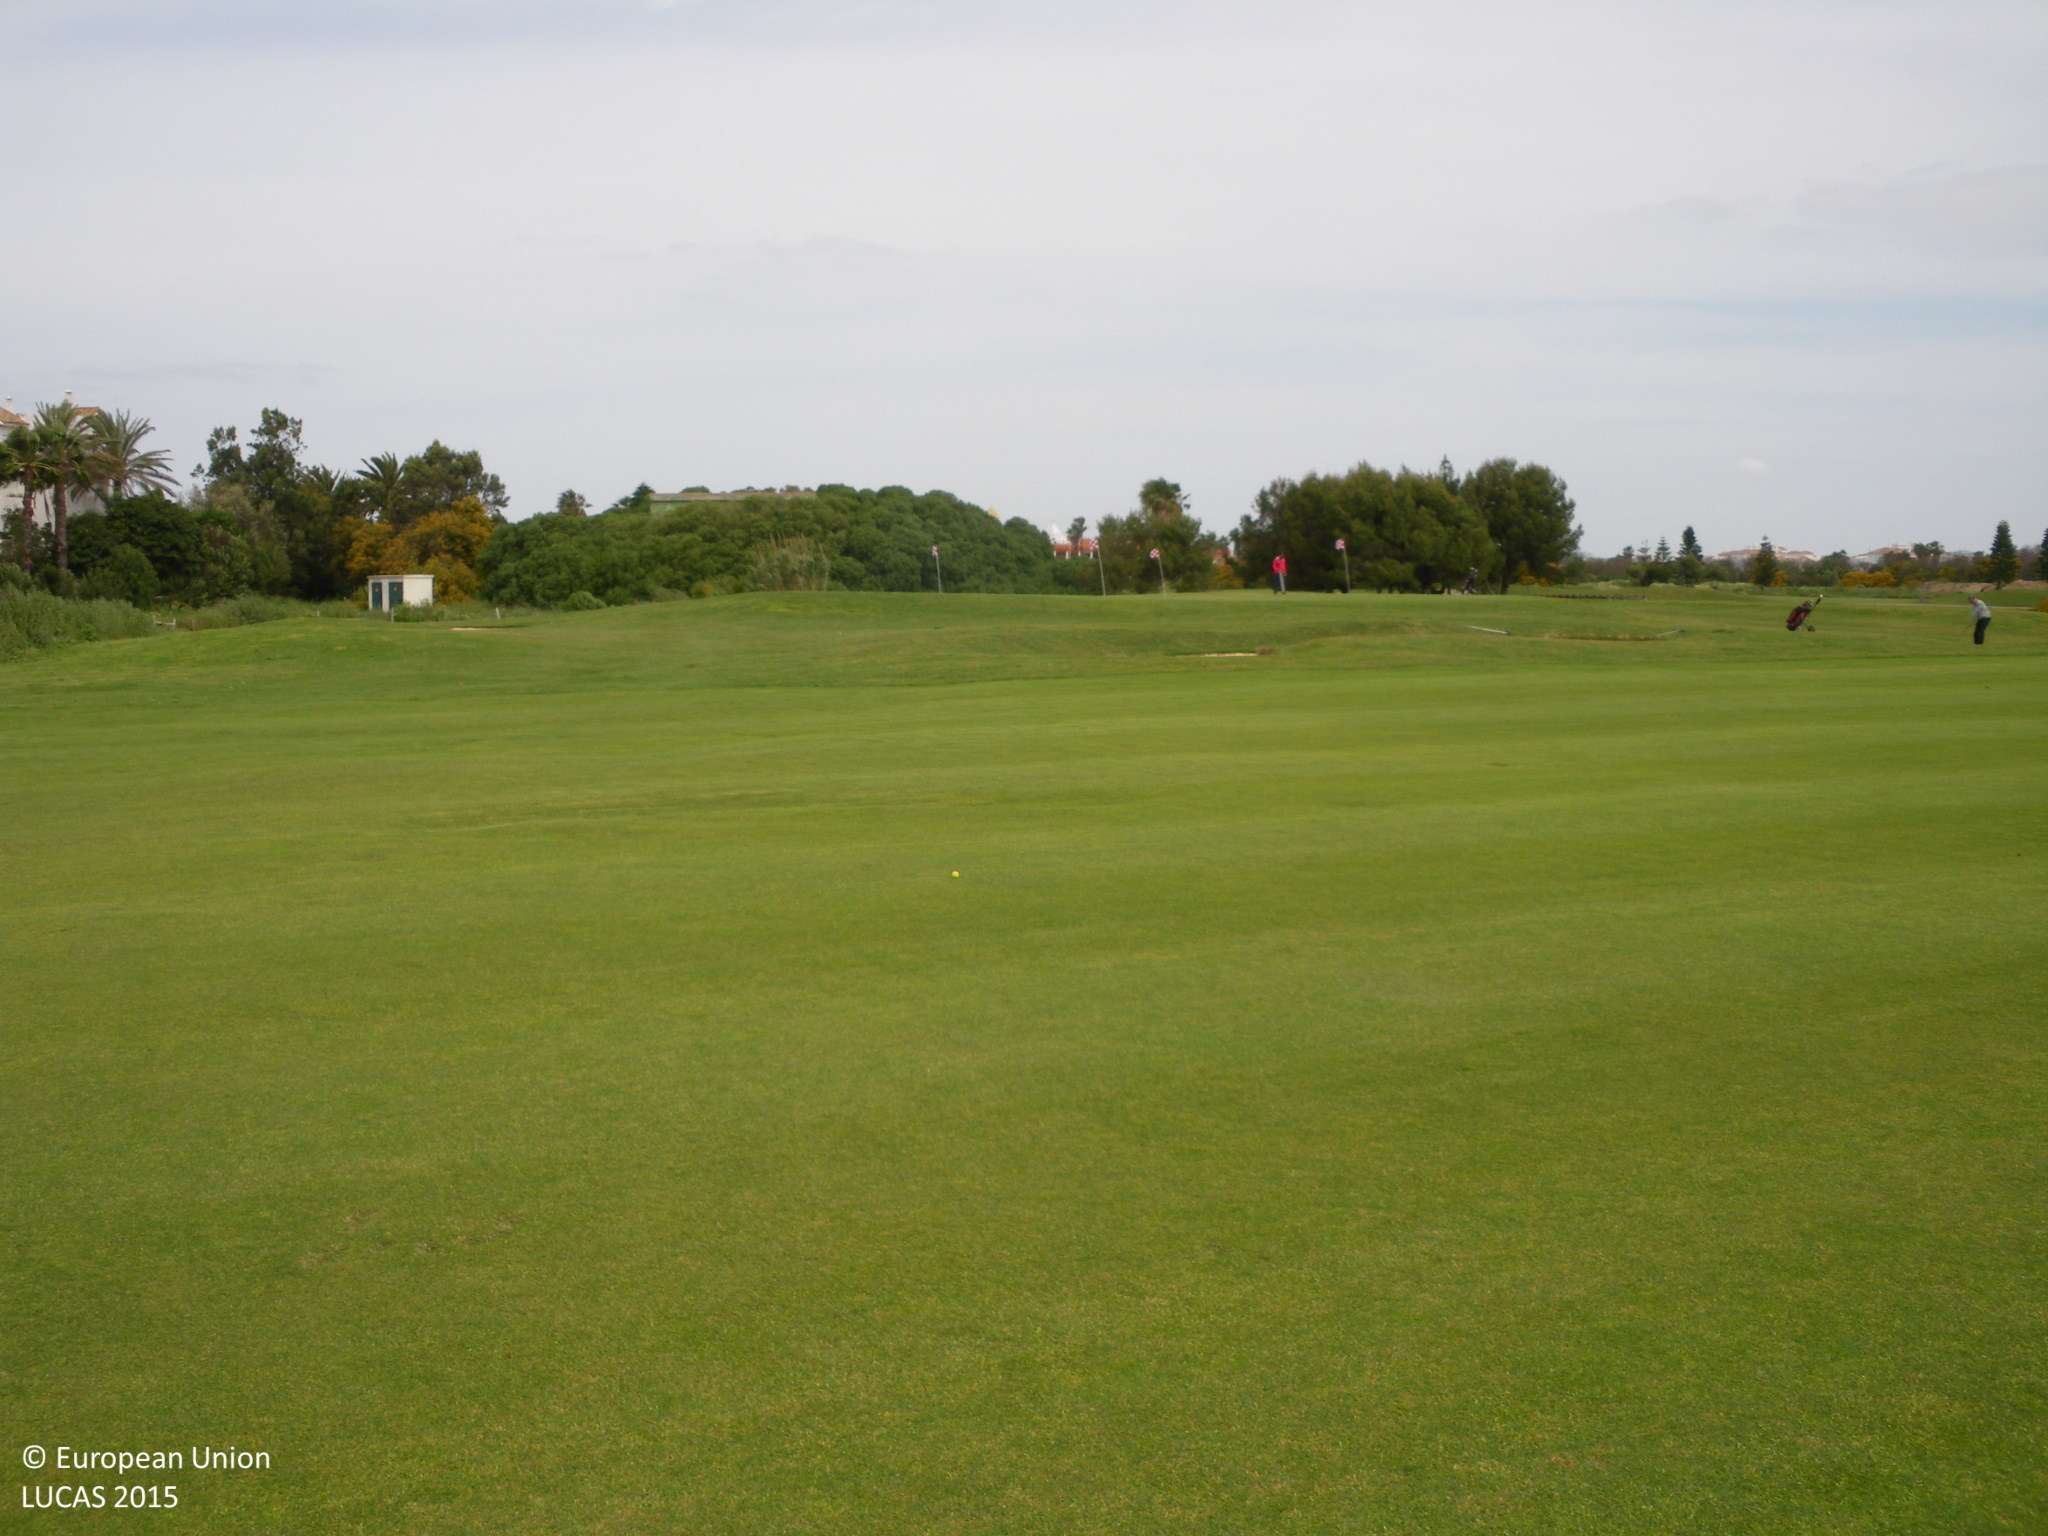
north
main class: Grassland
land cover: Grassland without tree/shrub cover
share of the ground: > 75 %
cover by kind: herbaceous plants 100 %
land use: Sport
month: April
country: ES
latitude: 36.6805
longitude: -6.4105
